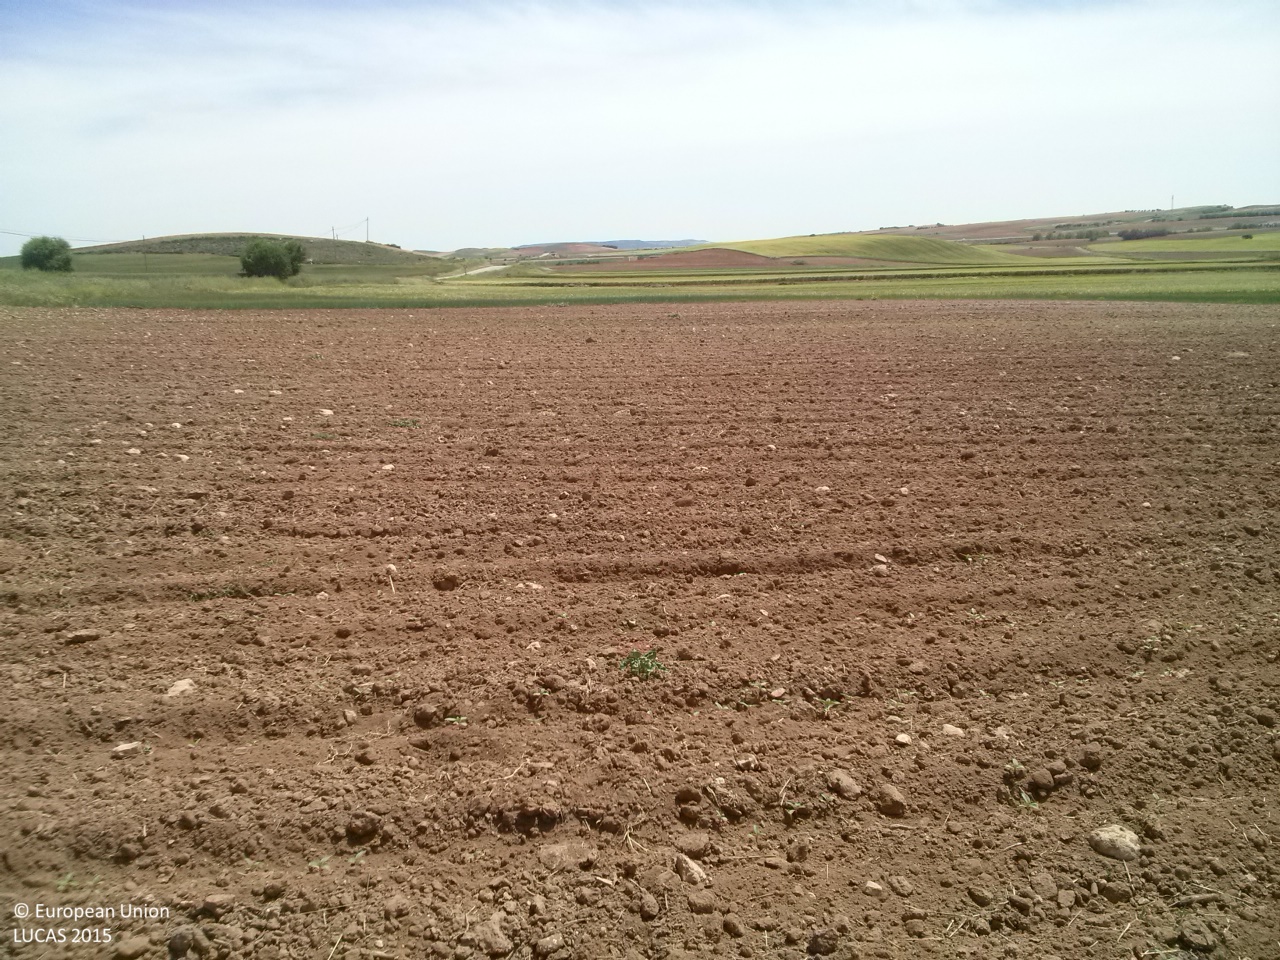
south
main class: Cropland
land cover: Sunflower
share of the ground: < 10 %
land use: Agriculture (excluding fallow land and kitchen gardens)
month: May
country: ES
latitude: 40.0432
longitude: -2.6908
